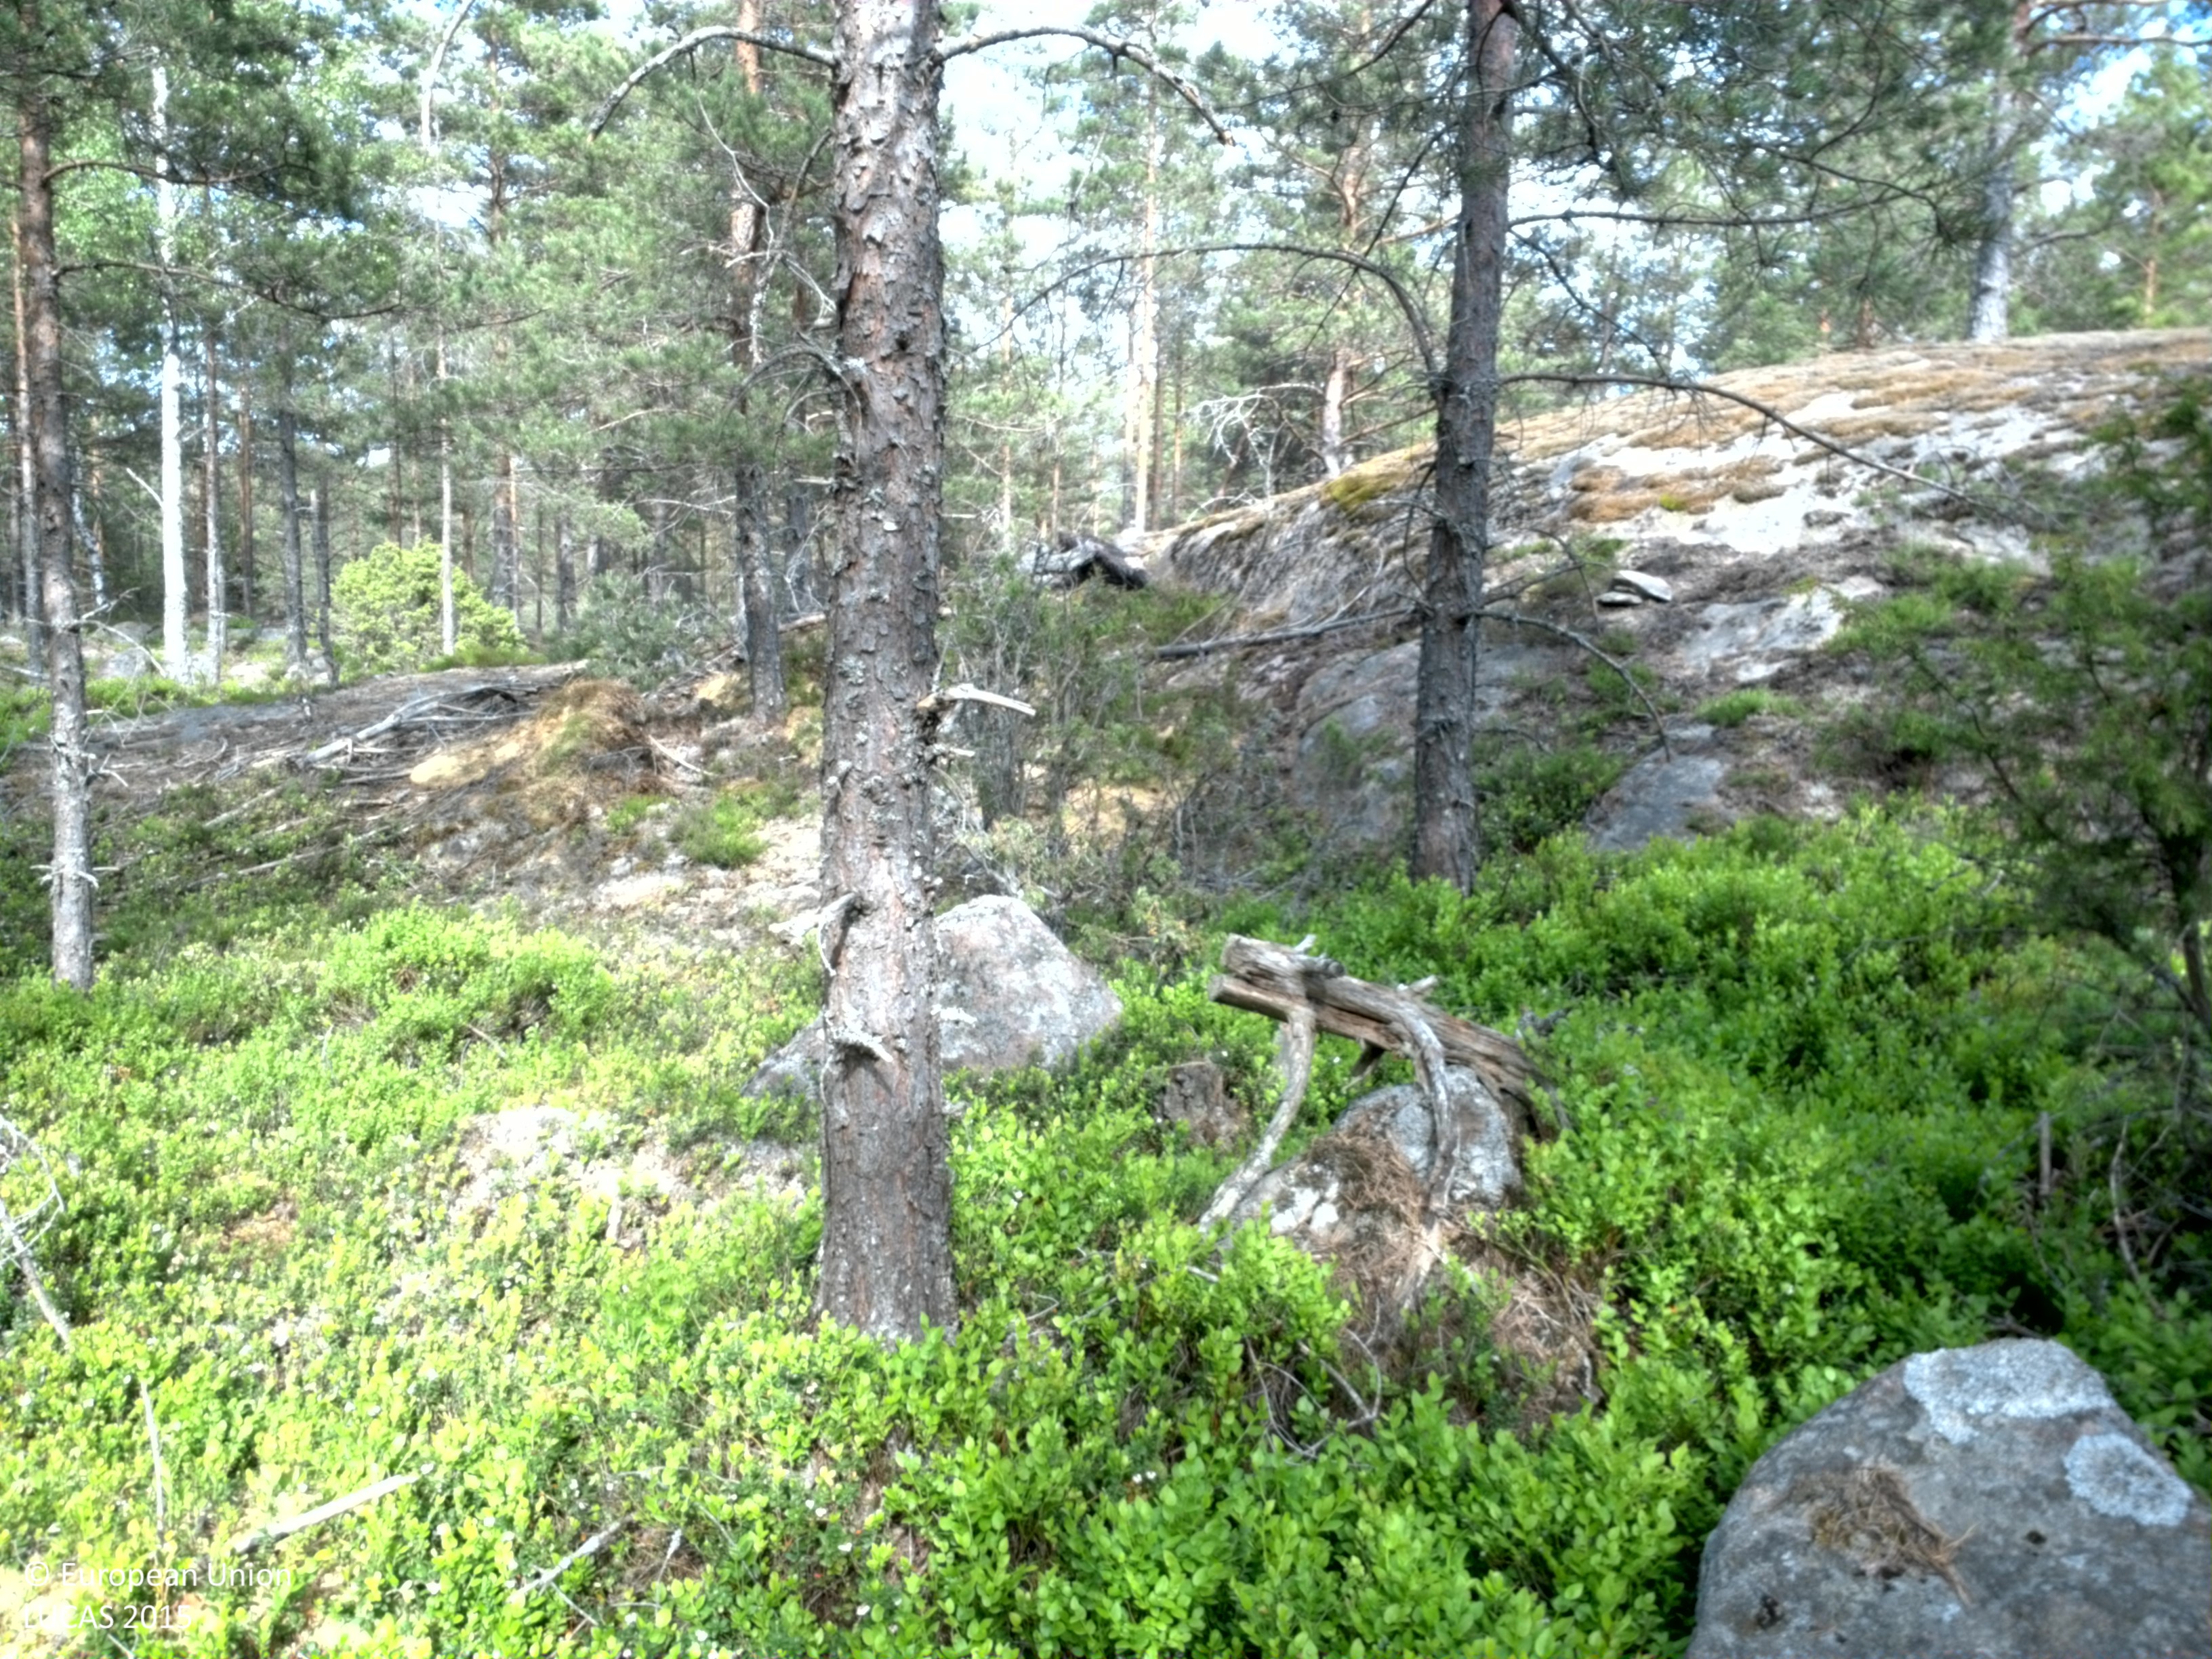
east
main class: Woodland
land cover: Pine dominated coniferous woodland
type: boreal forest
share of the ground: 10 - 25 %
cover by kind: lichens and mosses 35 %, shrubs 25 %, coniferous forest trees 20 %, unconsolidated bare surface 20 %
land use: Forestry
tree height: > 5 m
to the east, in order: Pine dominated coniferous woodland; Pine dominated mixed woodland
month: June
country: SE
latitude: 58.7186
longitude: 16.3664
